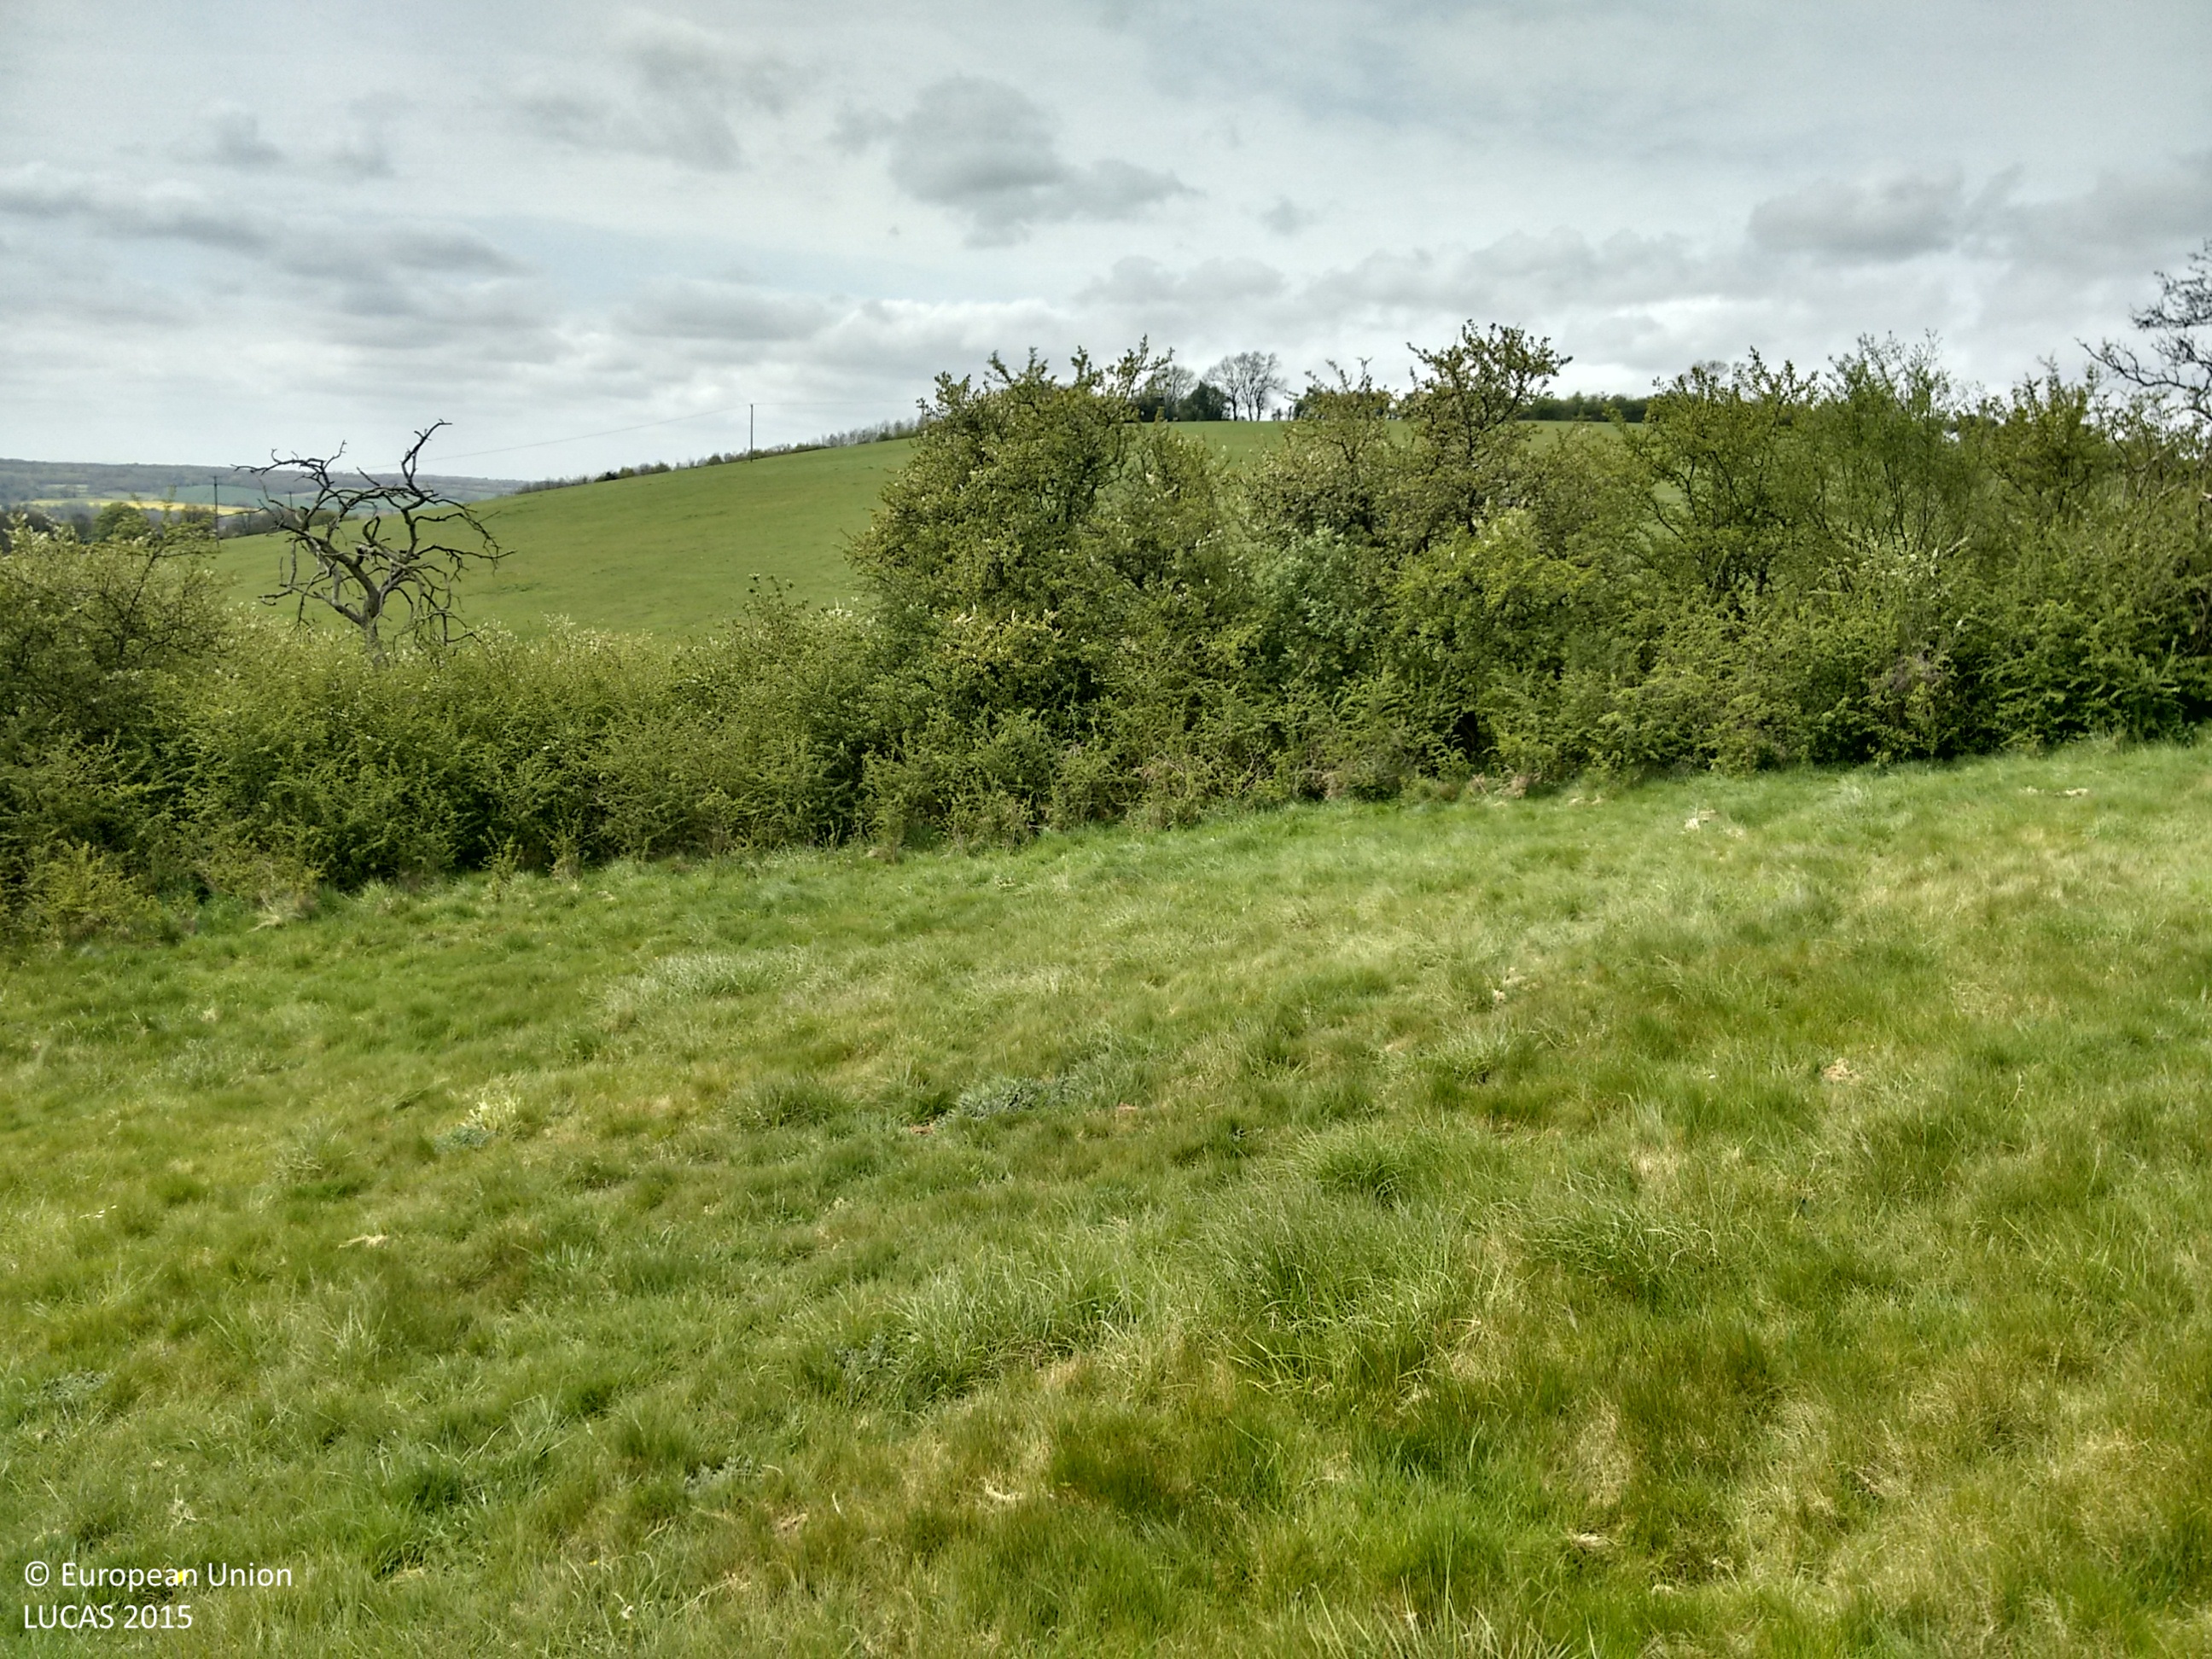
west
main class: Grassland
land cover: Grassland without tree/shrub cover
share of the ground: > 75 %
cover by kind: herbaceous plants 100 %
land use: Semi-natural and natural areas not in use
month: May
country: GB
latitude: 51.2518
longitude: 0.7040
